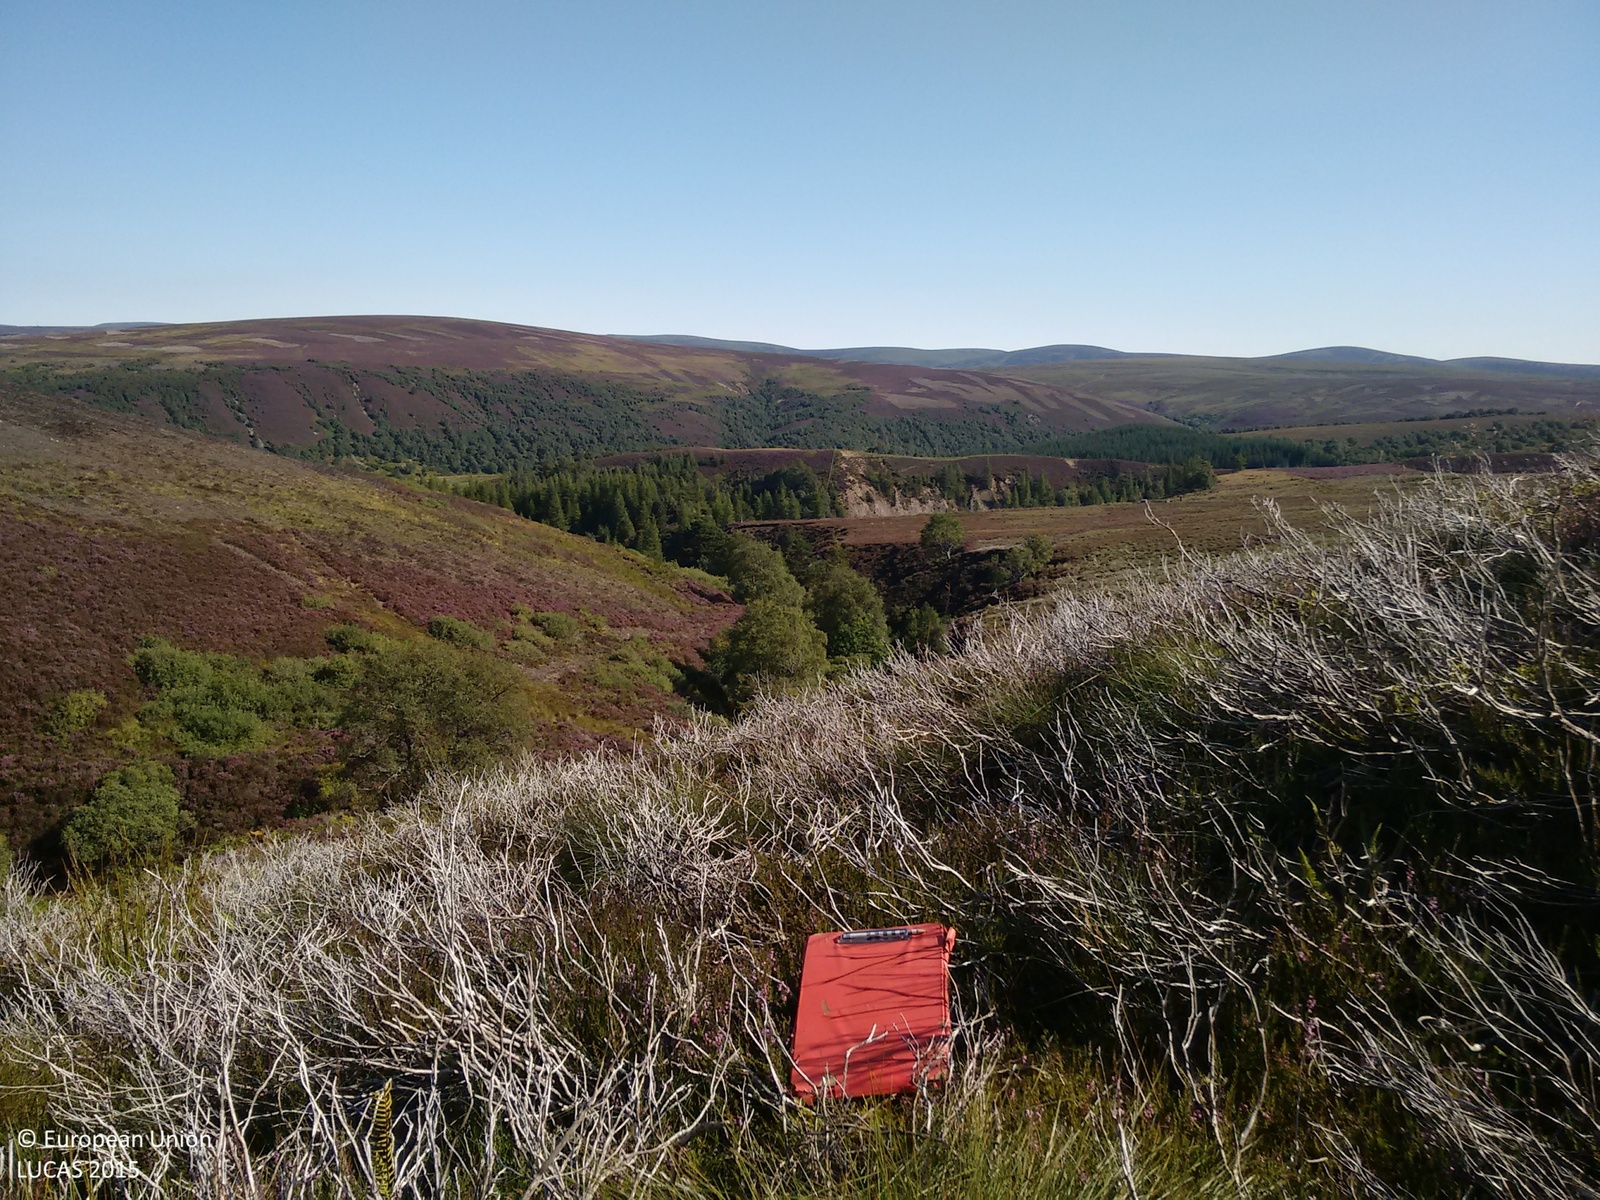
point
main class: Shrubland
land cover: Shrubland without tree cover
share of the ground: > 75 %
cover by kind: shrubs 80 %, herbaceous plants 15 %, lichens and mosses 5 %
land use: Agriculture (excluding fallow land and kitchen gardens)
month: September
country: GB
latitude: 57.2331
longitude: -3.4059
